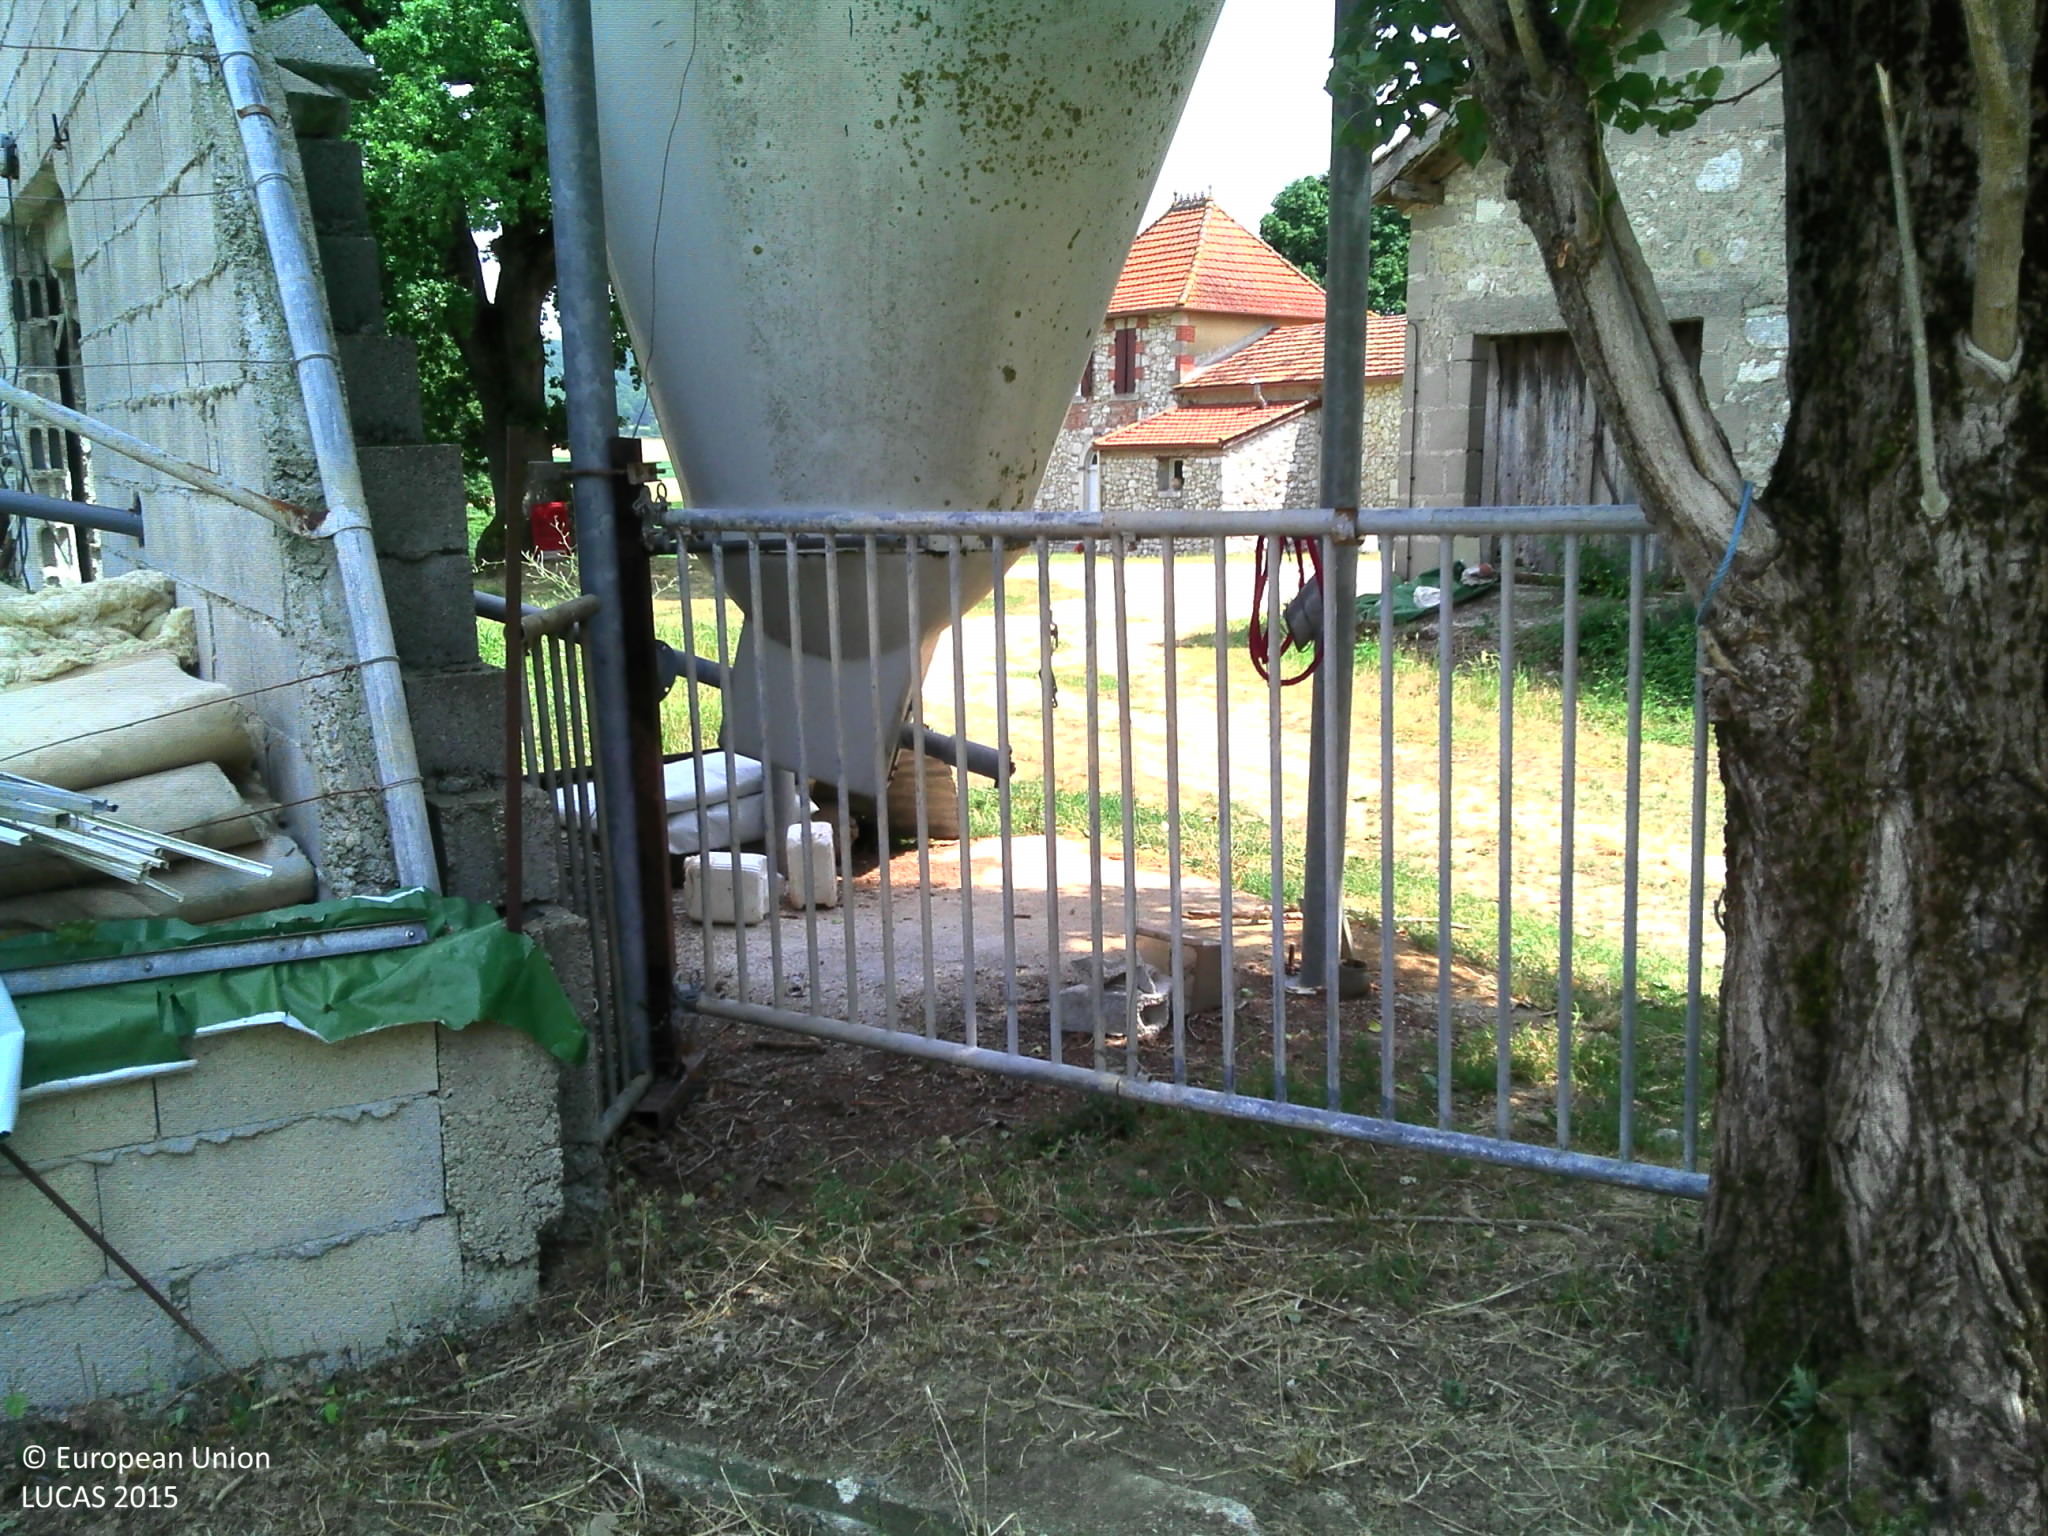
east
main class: Grassland
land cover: Grassland with sparse tree/shrub cover
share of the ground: > 75 %
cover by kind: herbaceous plants 95 %, coniferous forest trees 5 %
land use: Agriculture (excluding fallow land and kitchen gardens)
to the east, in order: Grassland with sparse tree/shrub cover; Artificial constructions in urban areas; Single bushes/trees; Tracks; Grassland without tree/shrub cover; Electric lines; Lucerne; Grass margins; Ditches and canals; Grass margins; Soya; Grass margins; Ditches and canals; Paved roads, cycling and walking lanes; Ditches and canals; Sunflower
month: July
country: FR
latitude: 44.4028
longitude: 0.8921
